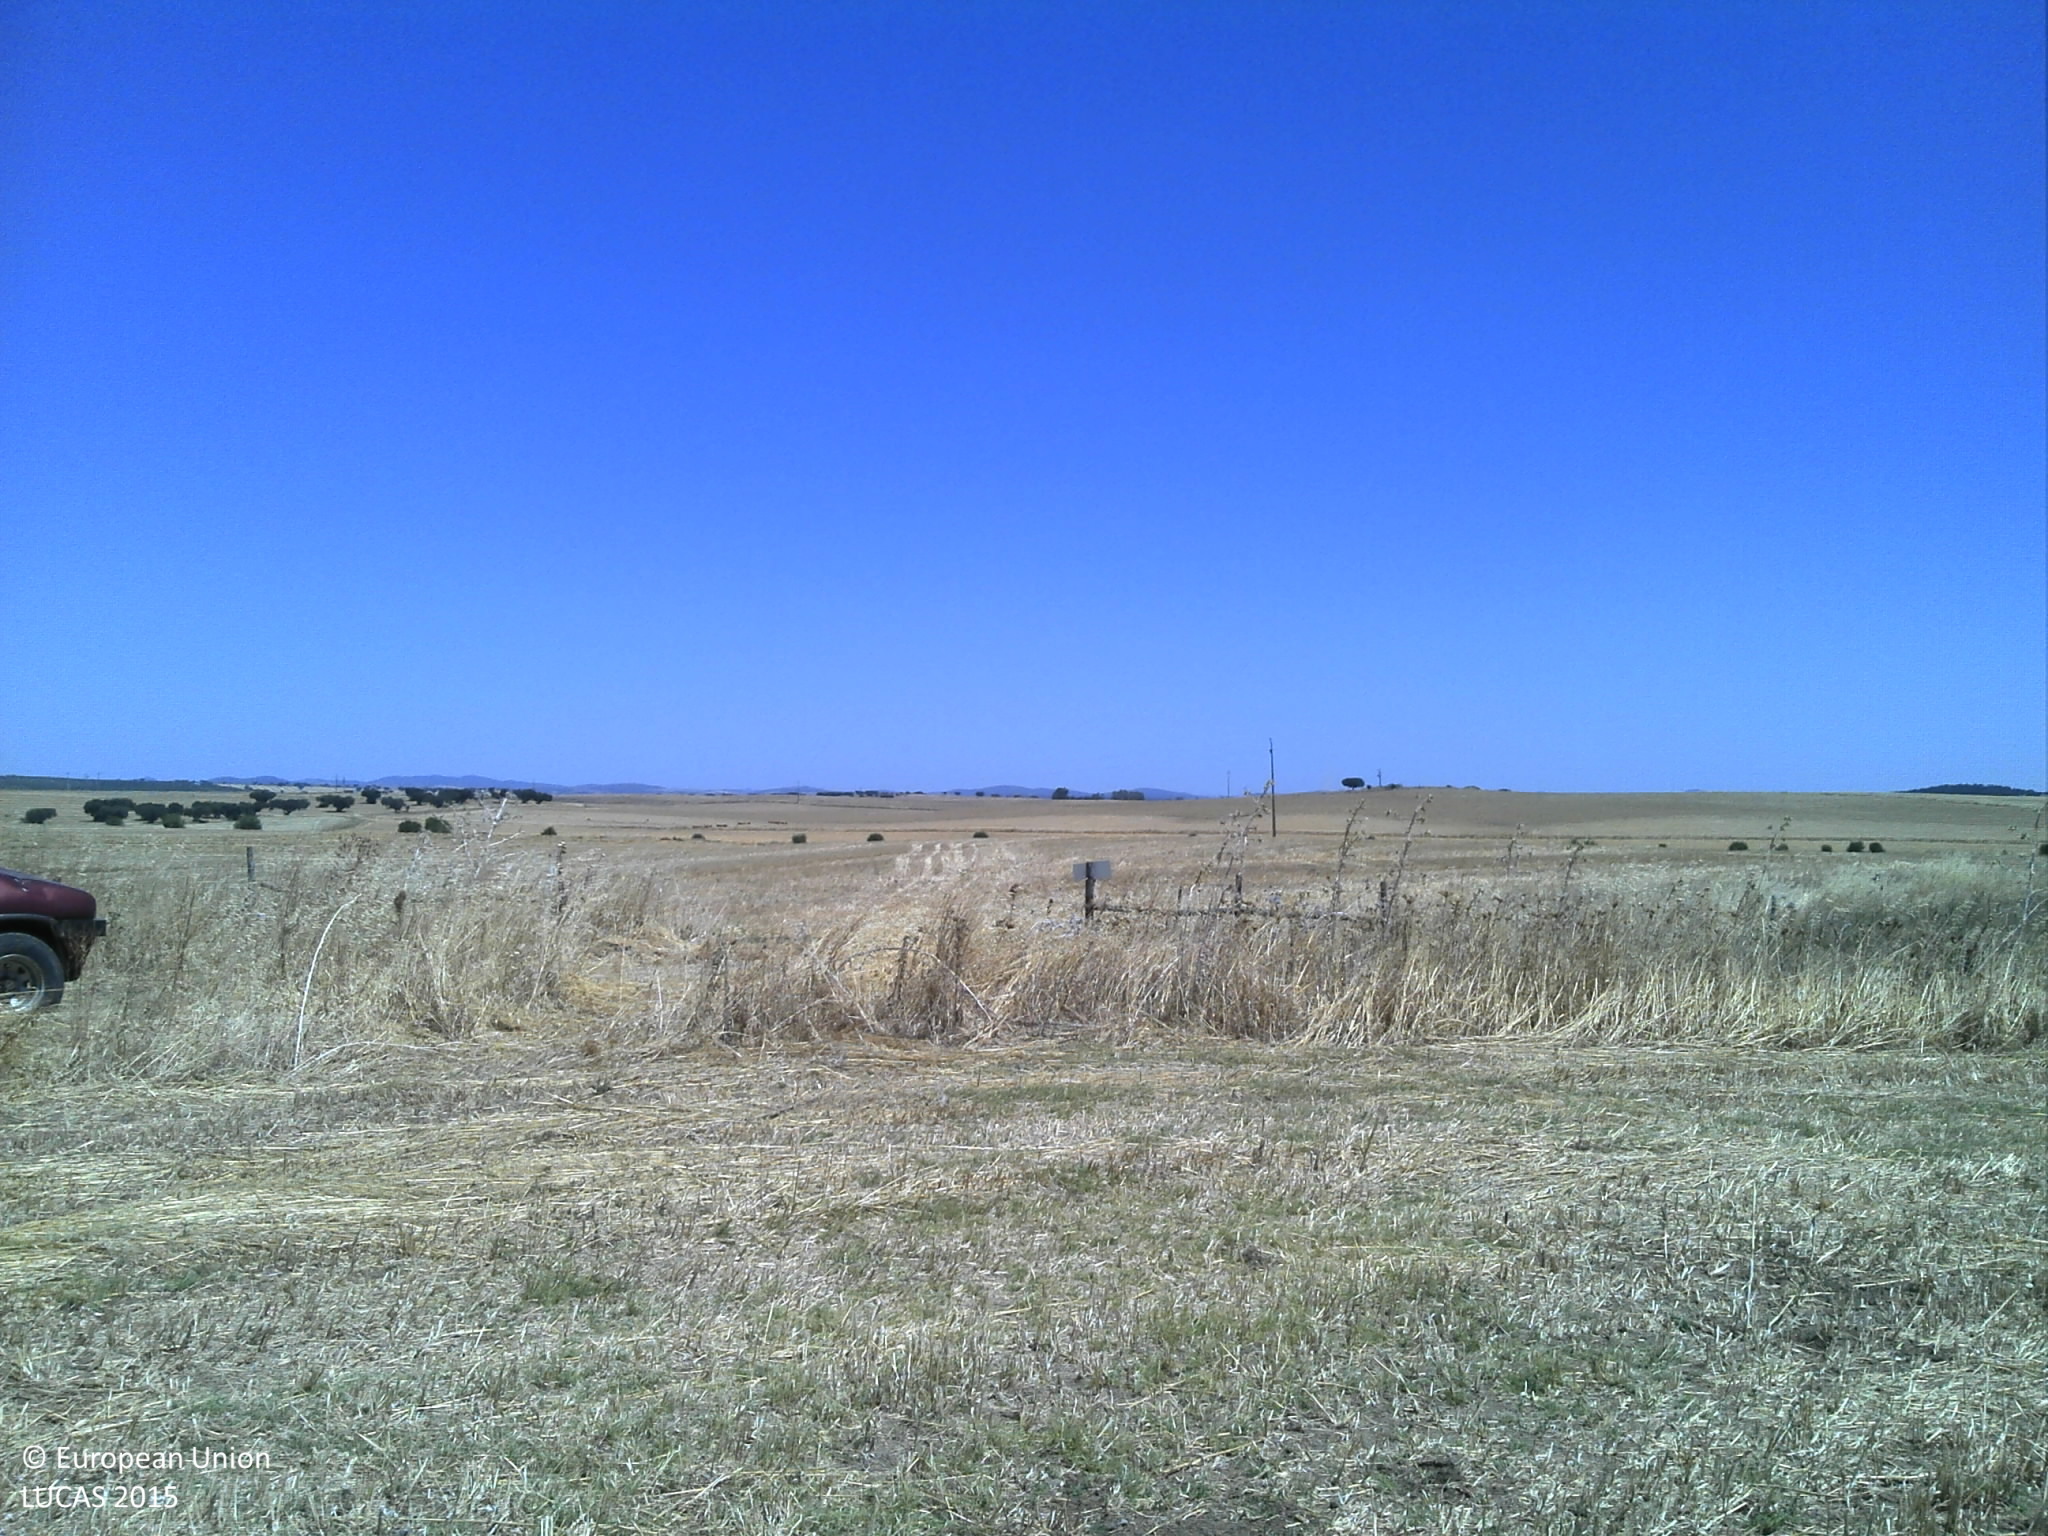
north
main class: Cropland
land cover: Oats
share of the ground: < 10 %
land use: Agriculture (excluding fallow land and kitchen gardens)
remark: Harvested field
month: July
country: PT
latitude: 38.9734
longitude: -7.0050
